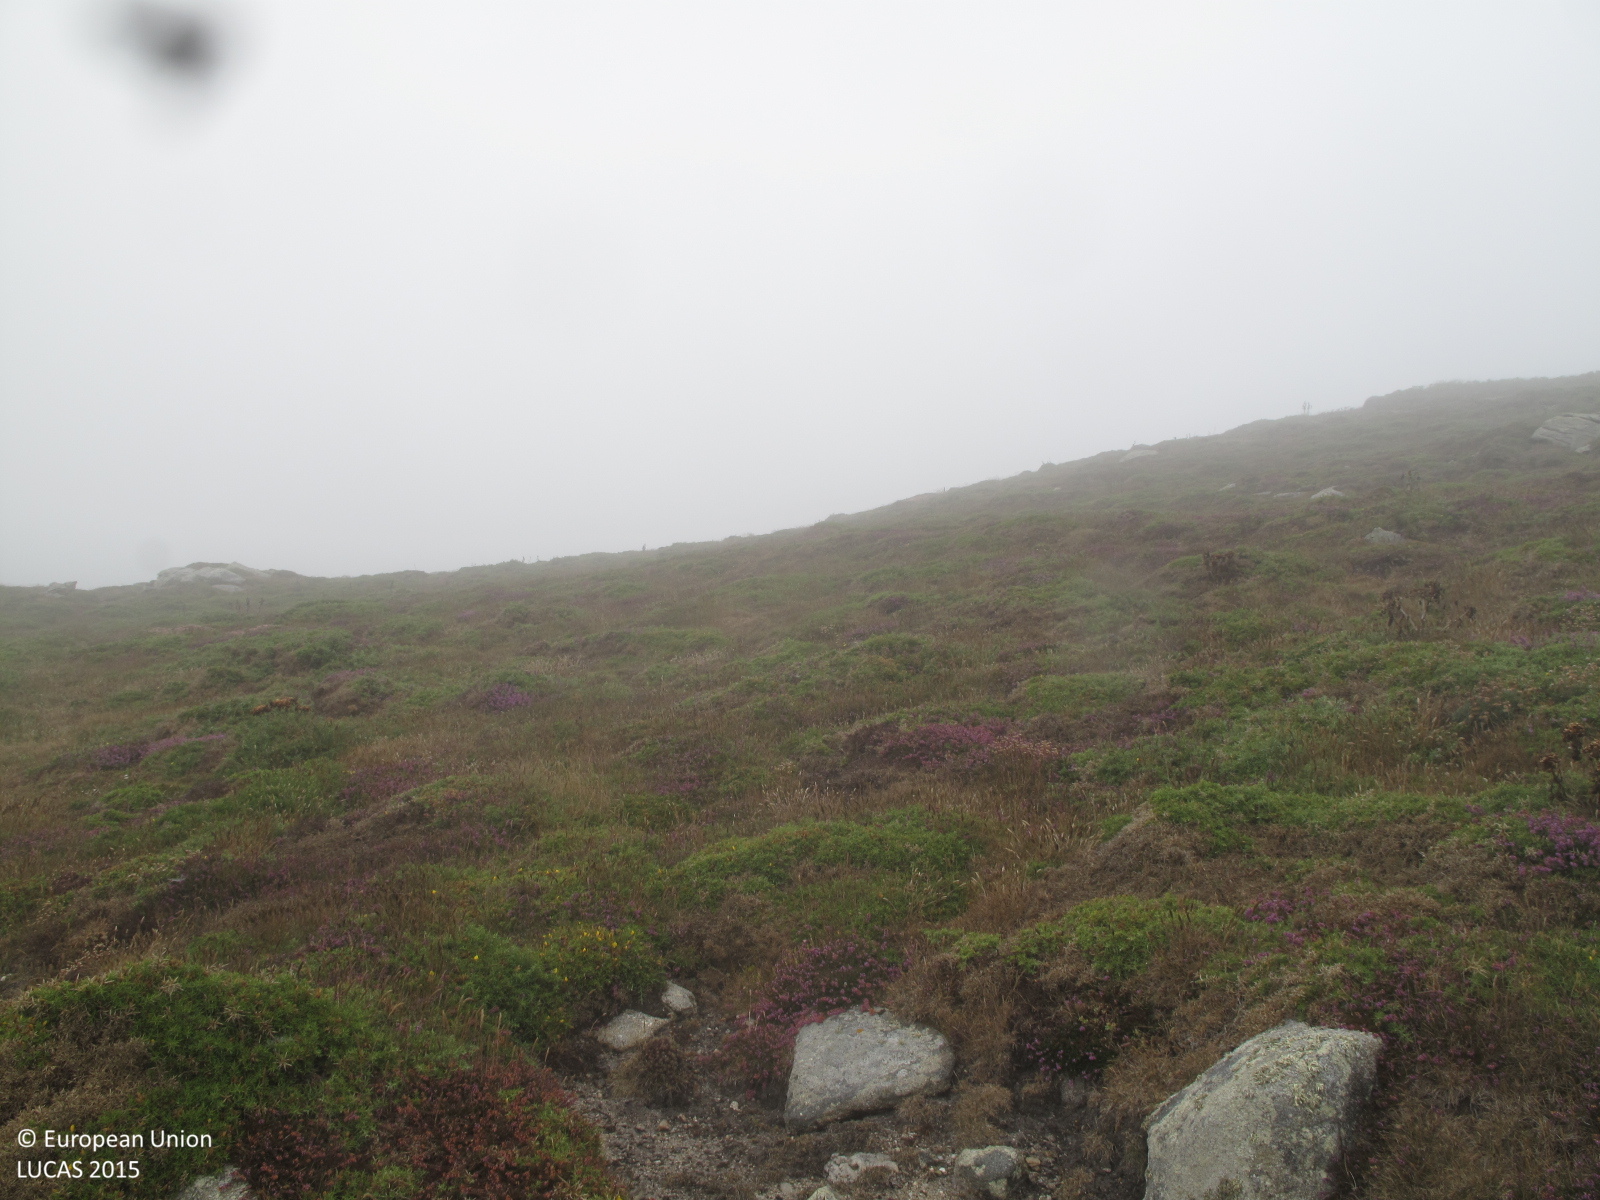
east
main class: Shrubland
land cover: Shrubland without tree cover
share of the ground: 50 - 75 %
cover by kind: shrubs 70 %, herbaceous plants 10 %, lichens and mosses 10 %, consolidated bare surface 10 %
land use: Semi-natural and natural areas not in use
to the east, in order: Shrubland without tree cover; Tracks; Shrubland without tree cover
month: July
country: ES
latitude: 43.0544
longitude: -9.2973
